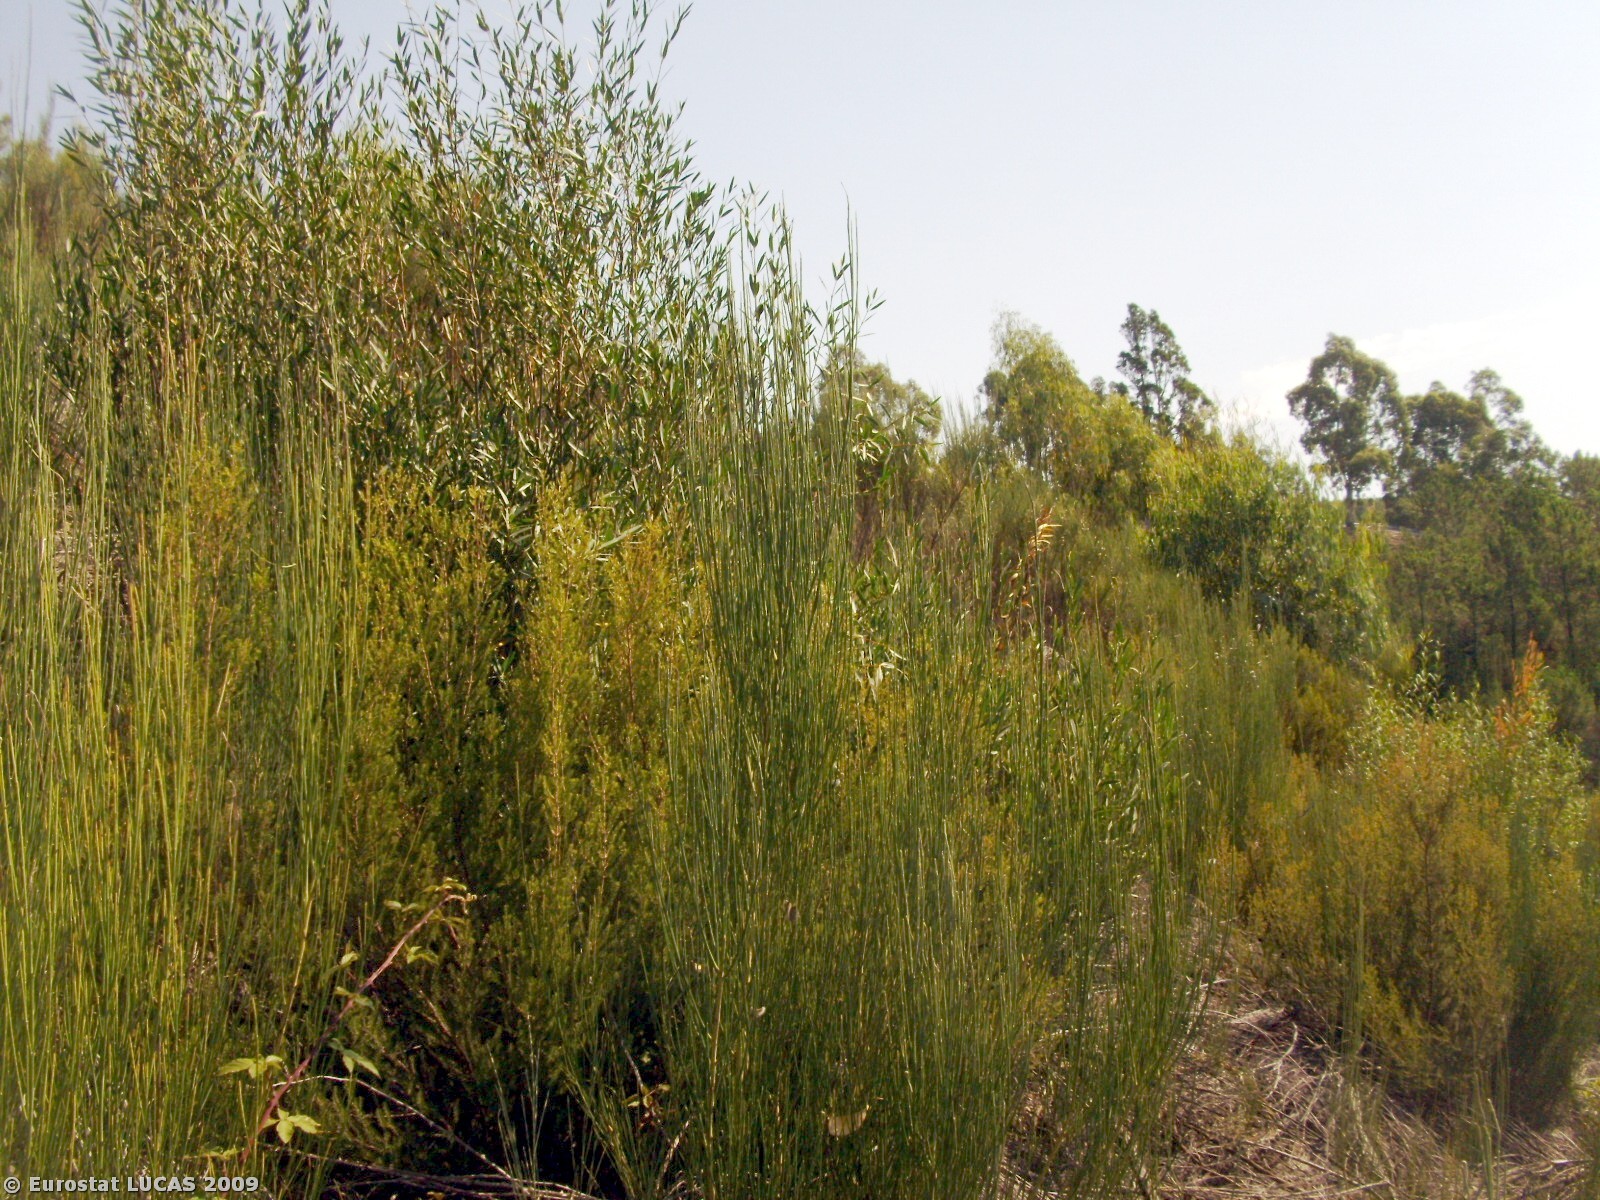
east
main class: Shrubland
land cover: Shrubland without tree cover
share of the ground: > 75 %
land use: Forestry
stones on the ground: > 50 %
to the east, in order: Shrubland without tree cover; Coniferous woodland; Shrubland with sparse tree cover
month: August
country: PT
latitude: 40.2389
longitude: -7.6597
